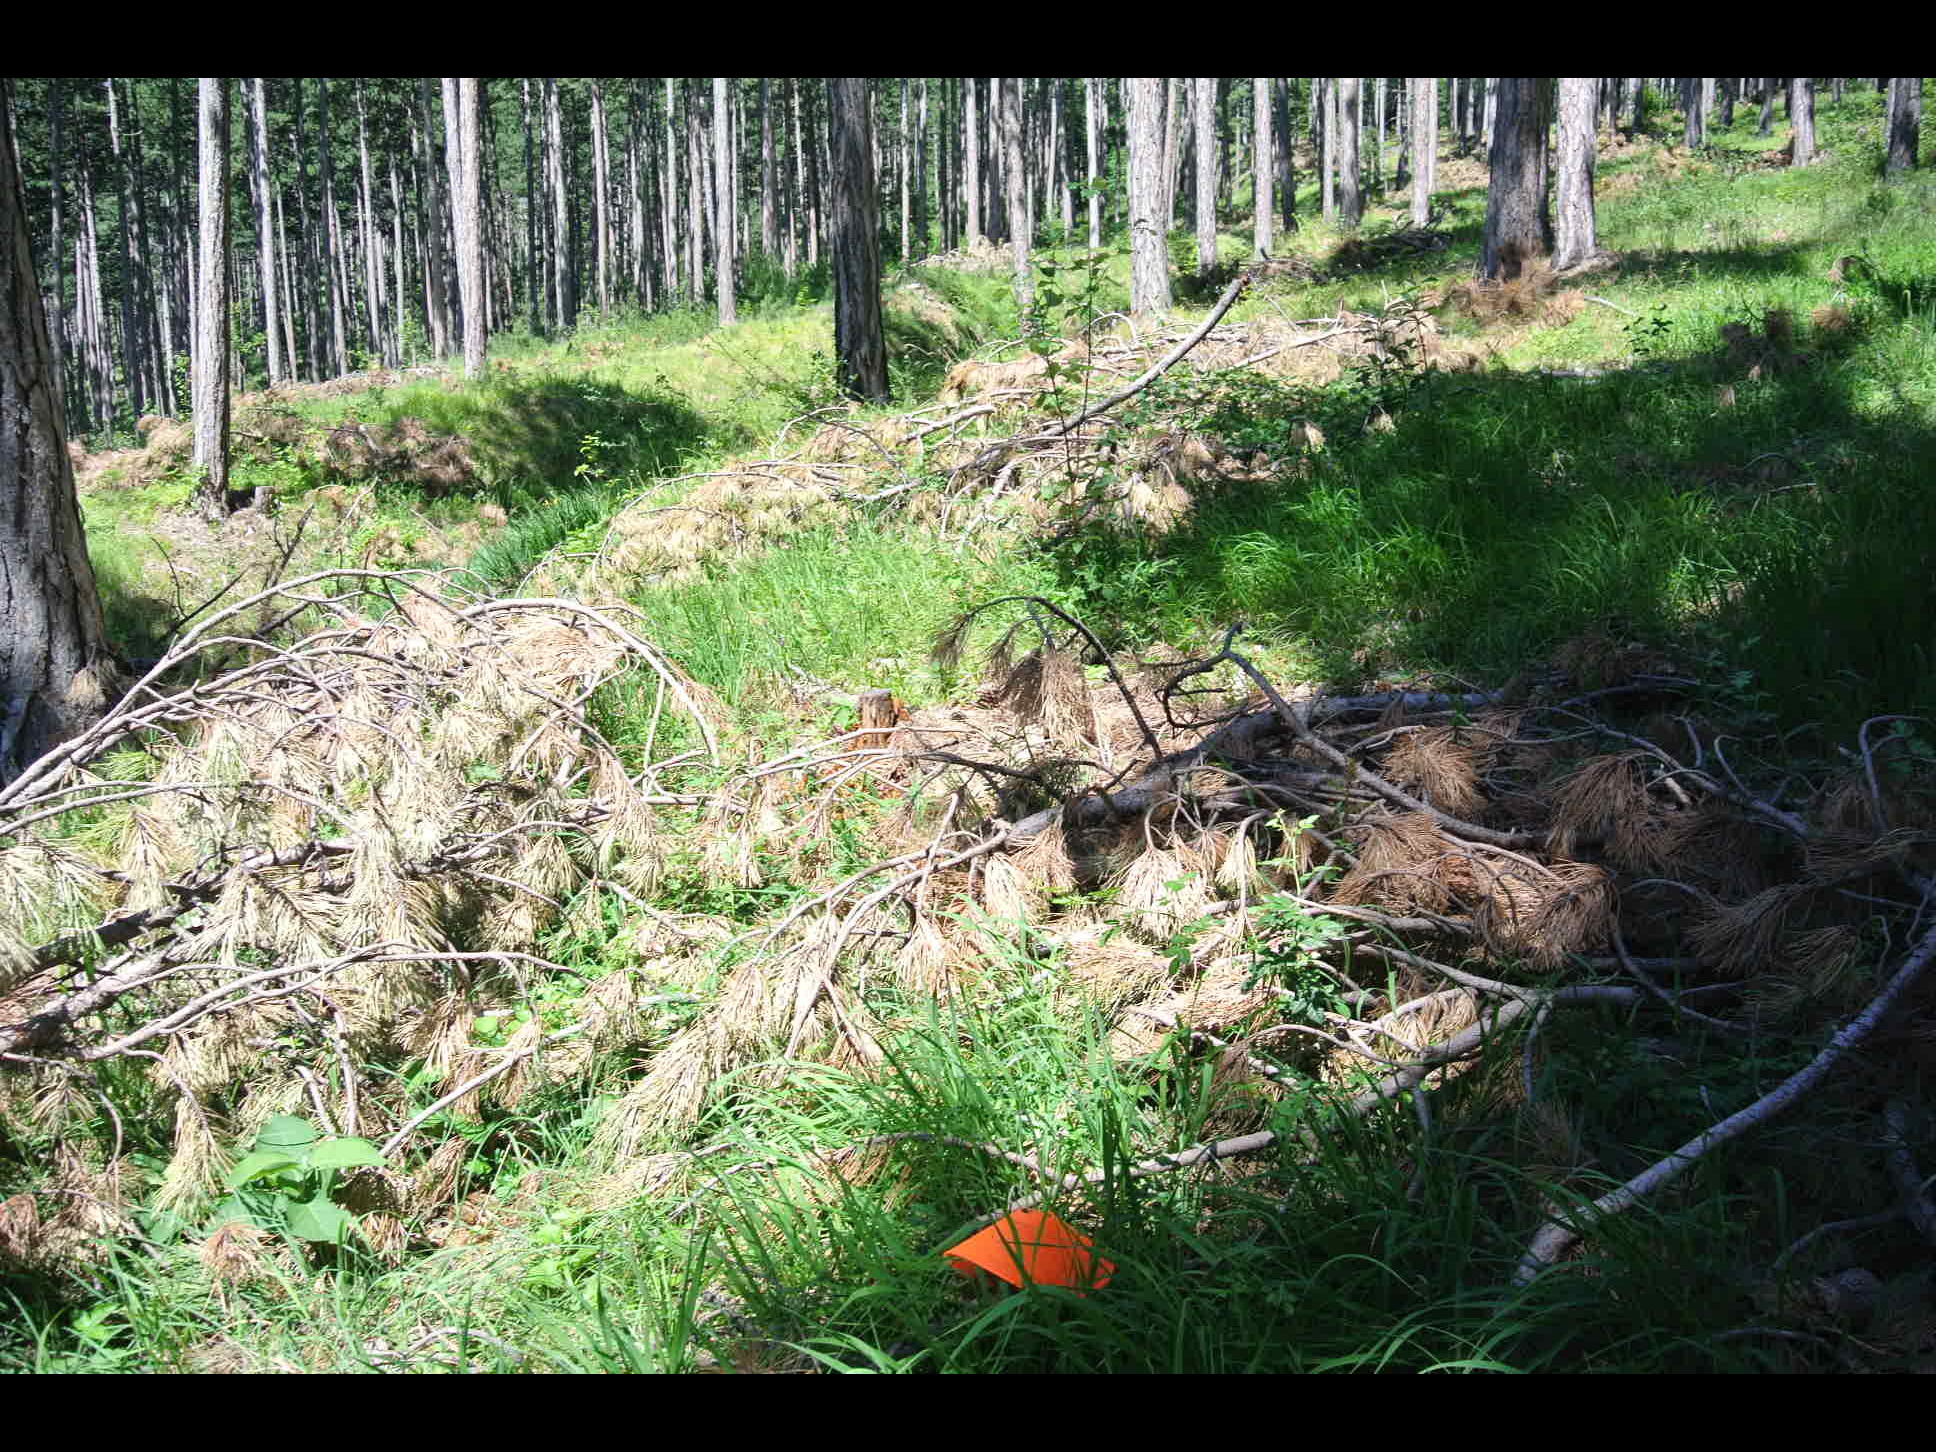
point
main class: Woodland
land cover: Pine dominated coniferous woodland
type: alpine coniferous forest
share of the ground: > 75 %
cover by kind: coniferous forest trees 100 %
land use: Forestry
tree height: > 5 m
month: July
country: AT
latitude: 47.7344
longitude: 16.0166
